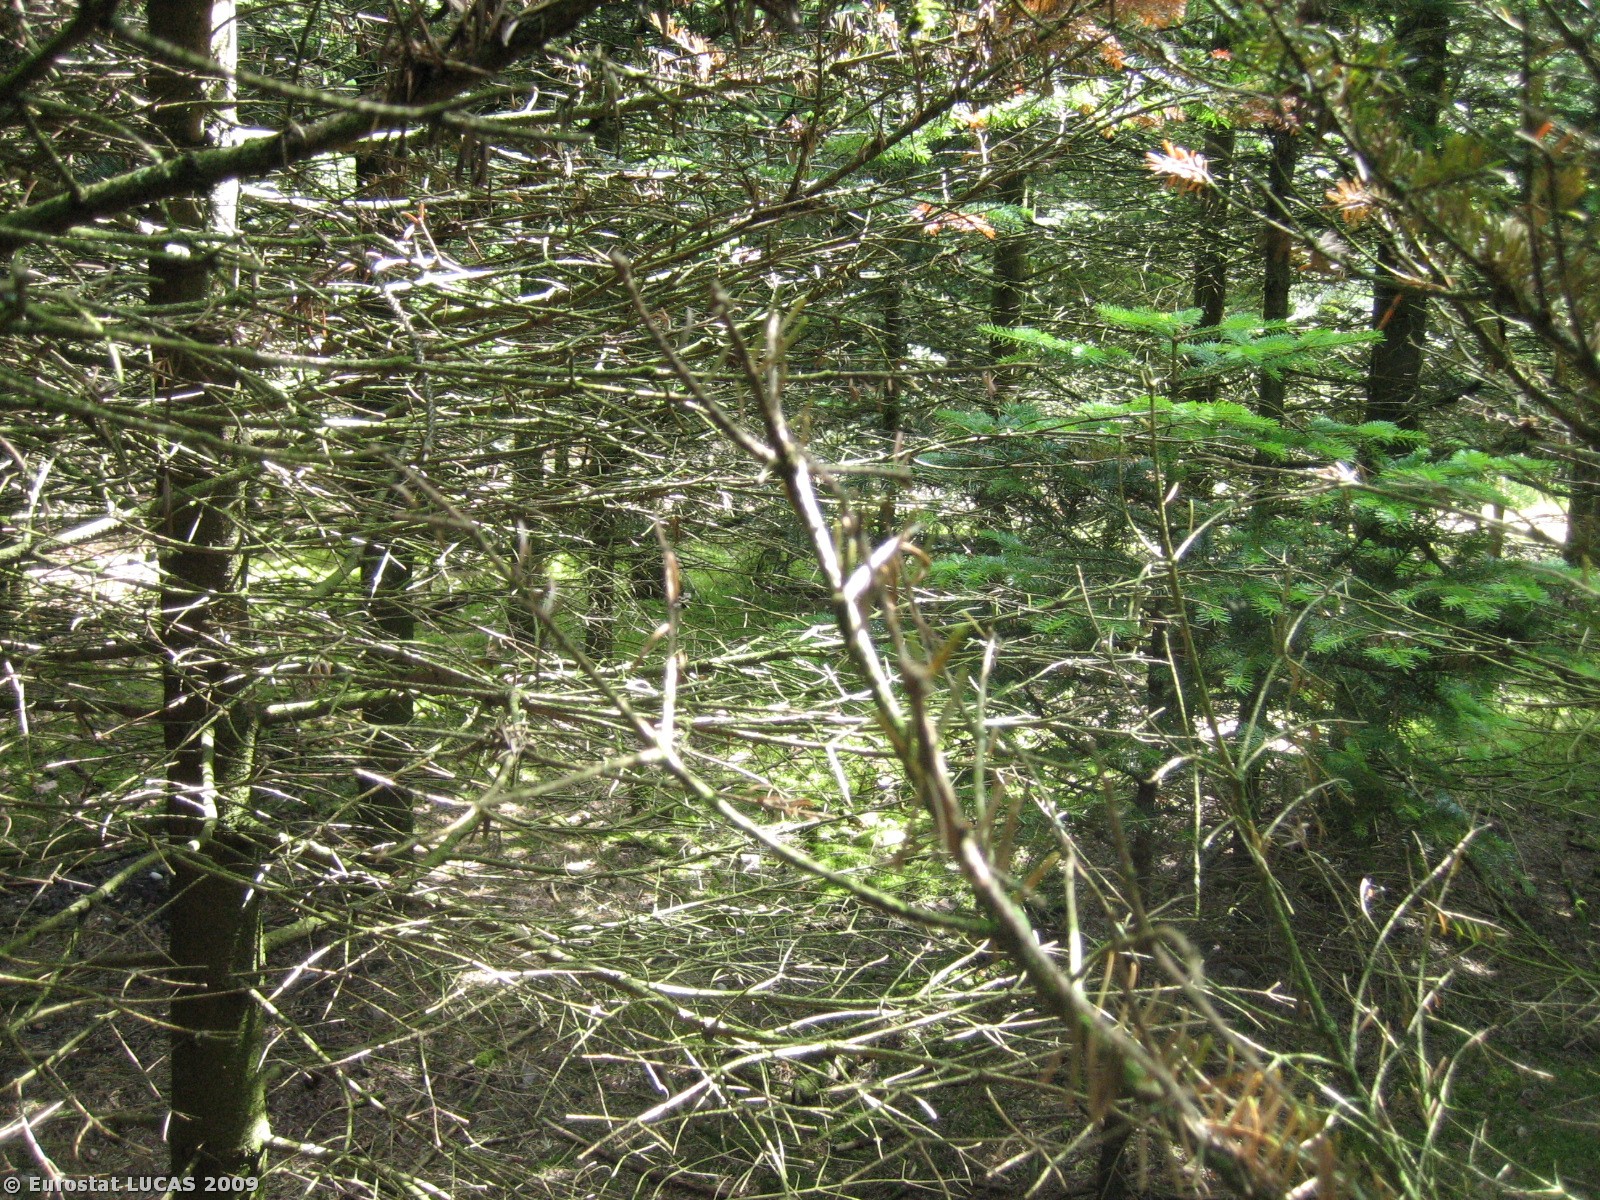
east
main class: Woodland
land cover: Coniferous woodland
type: hemiboreal forest and nemoral coniferous forest and mixed broadleaved-coniferous forest
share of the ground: > 75 %
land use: Forestry
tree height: > 5 m
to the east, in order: Coniferous woodland; Broadleaved woodland; Grassland with sparse tree/shrub cover; Single bushes/trees; Grass margins; Paved roads, cycling and walking lanes; Single bushes/trees; Barley; Broadleaved woodland; Maize
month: July
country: DK
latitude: 55.6977
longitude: 8.9033
